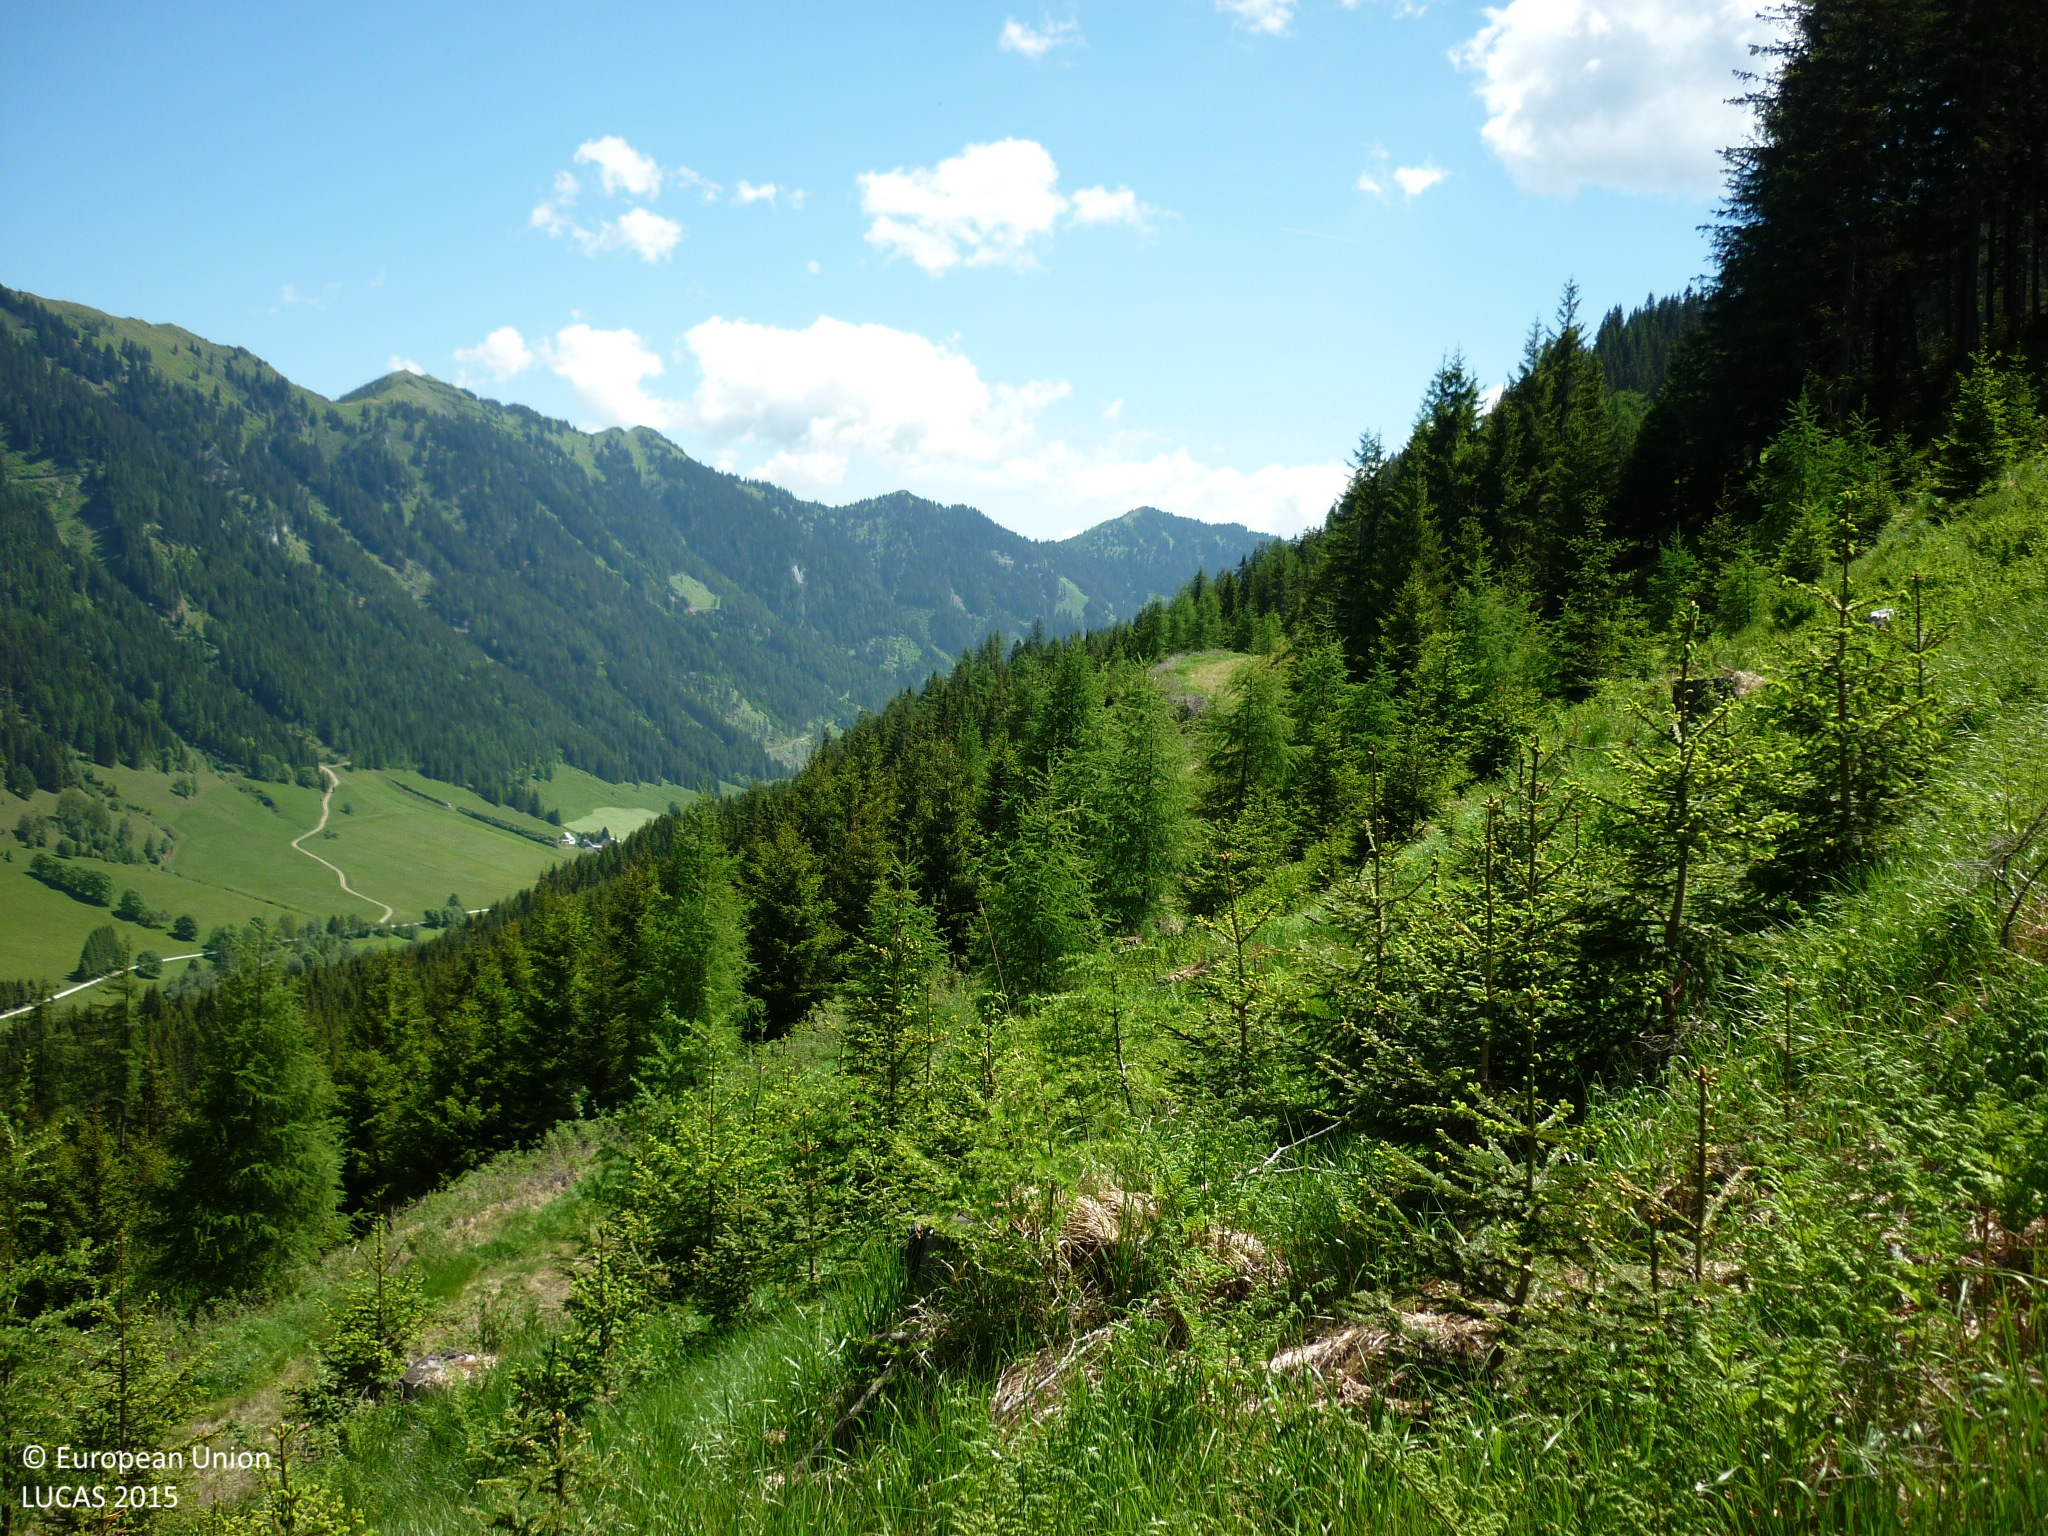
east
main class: Woodland
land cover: Spruce dominated coniferous woodland
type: alpine coniferous forest
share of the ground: 25 - 50 %
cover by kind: herbaceous plants 70 %, coniferous forest trees 25 %, shrubs 5 %
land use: Forestry
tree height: < 5 m
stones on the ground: < 10 %
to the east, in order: Spruce dominated coniferous woodland; Other coniferous woodland; Tracks; Spruce dominated coniferous woodland; Tracks; Shrubland with sparse tree cover; Tracks; Other coniferous woodland; Tracks
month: June
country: AT
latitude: 47.3477
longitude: 14.2743
